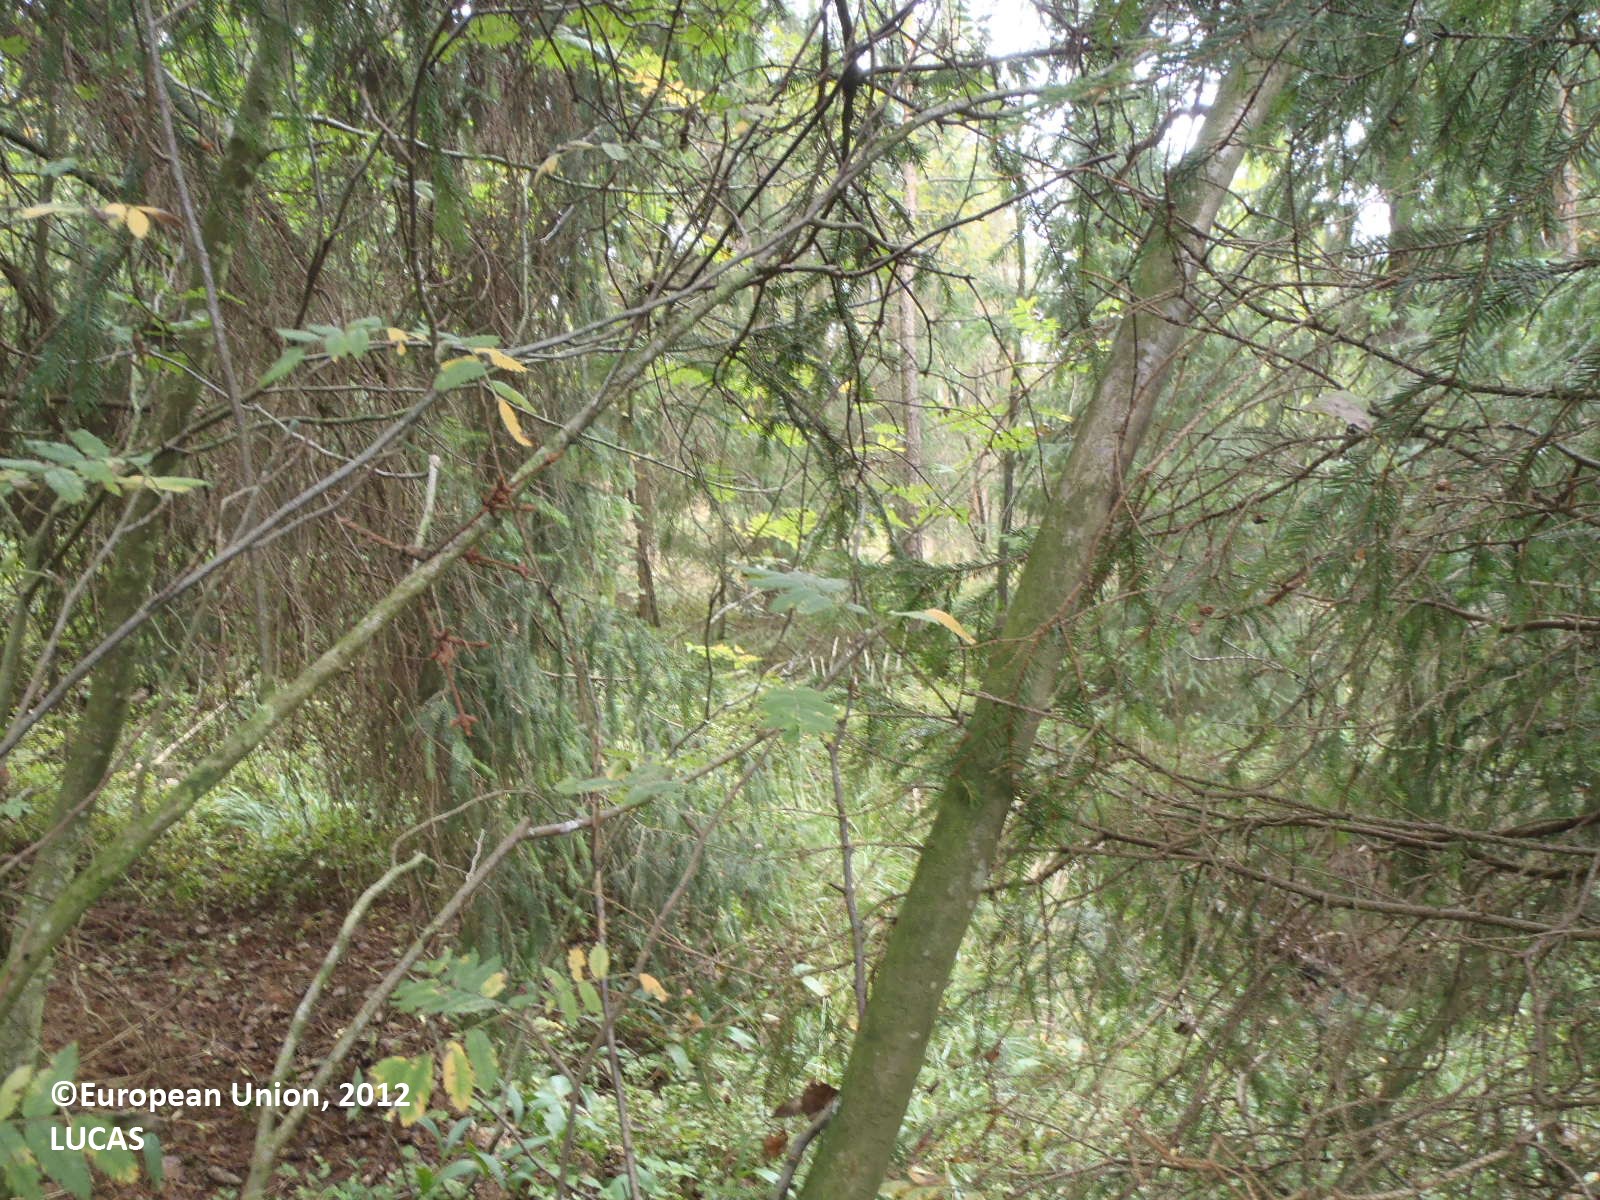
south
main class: Woodland
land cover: Spruce dominated coniferous woodland
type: boreal forest
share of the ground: > 75 %
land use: Forestry
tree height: > 5 m
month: August
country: FI
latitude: 60.7161
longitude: 21.8815
